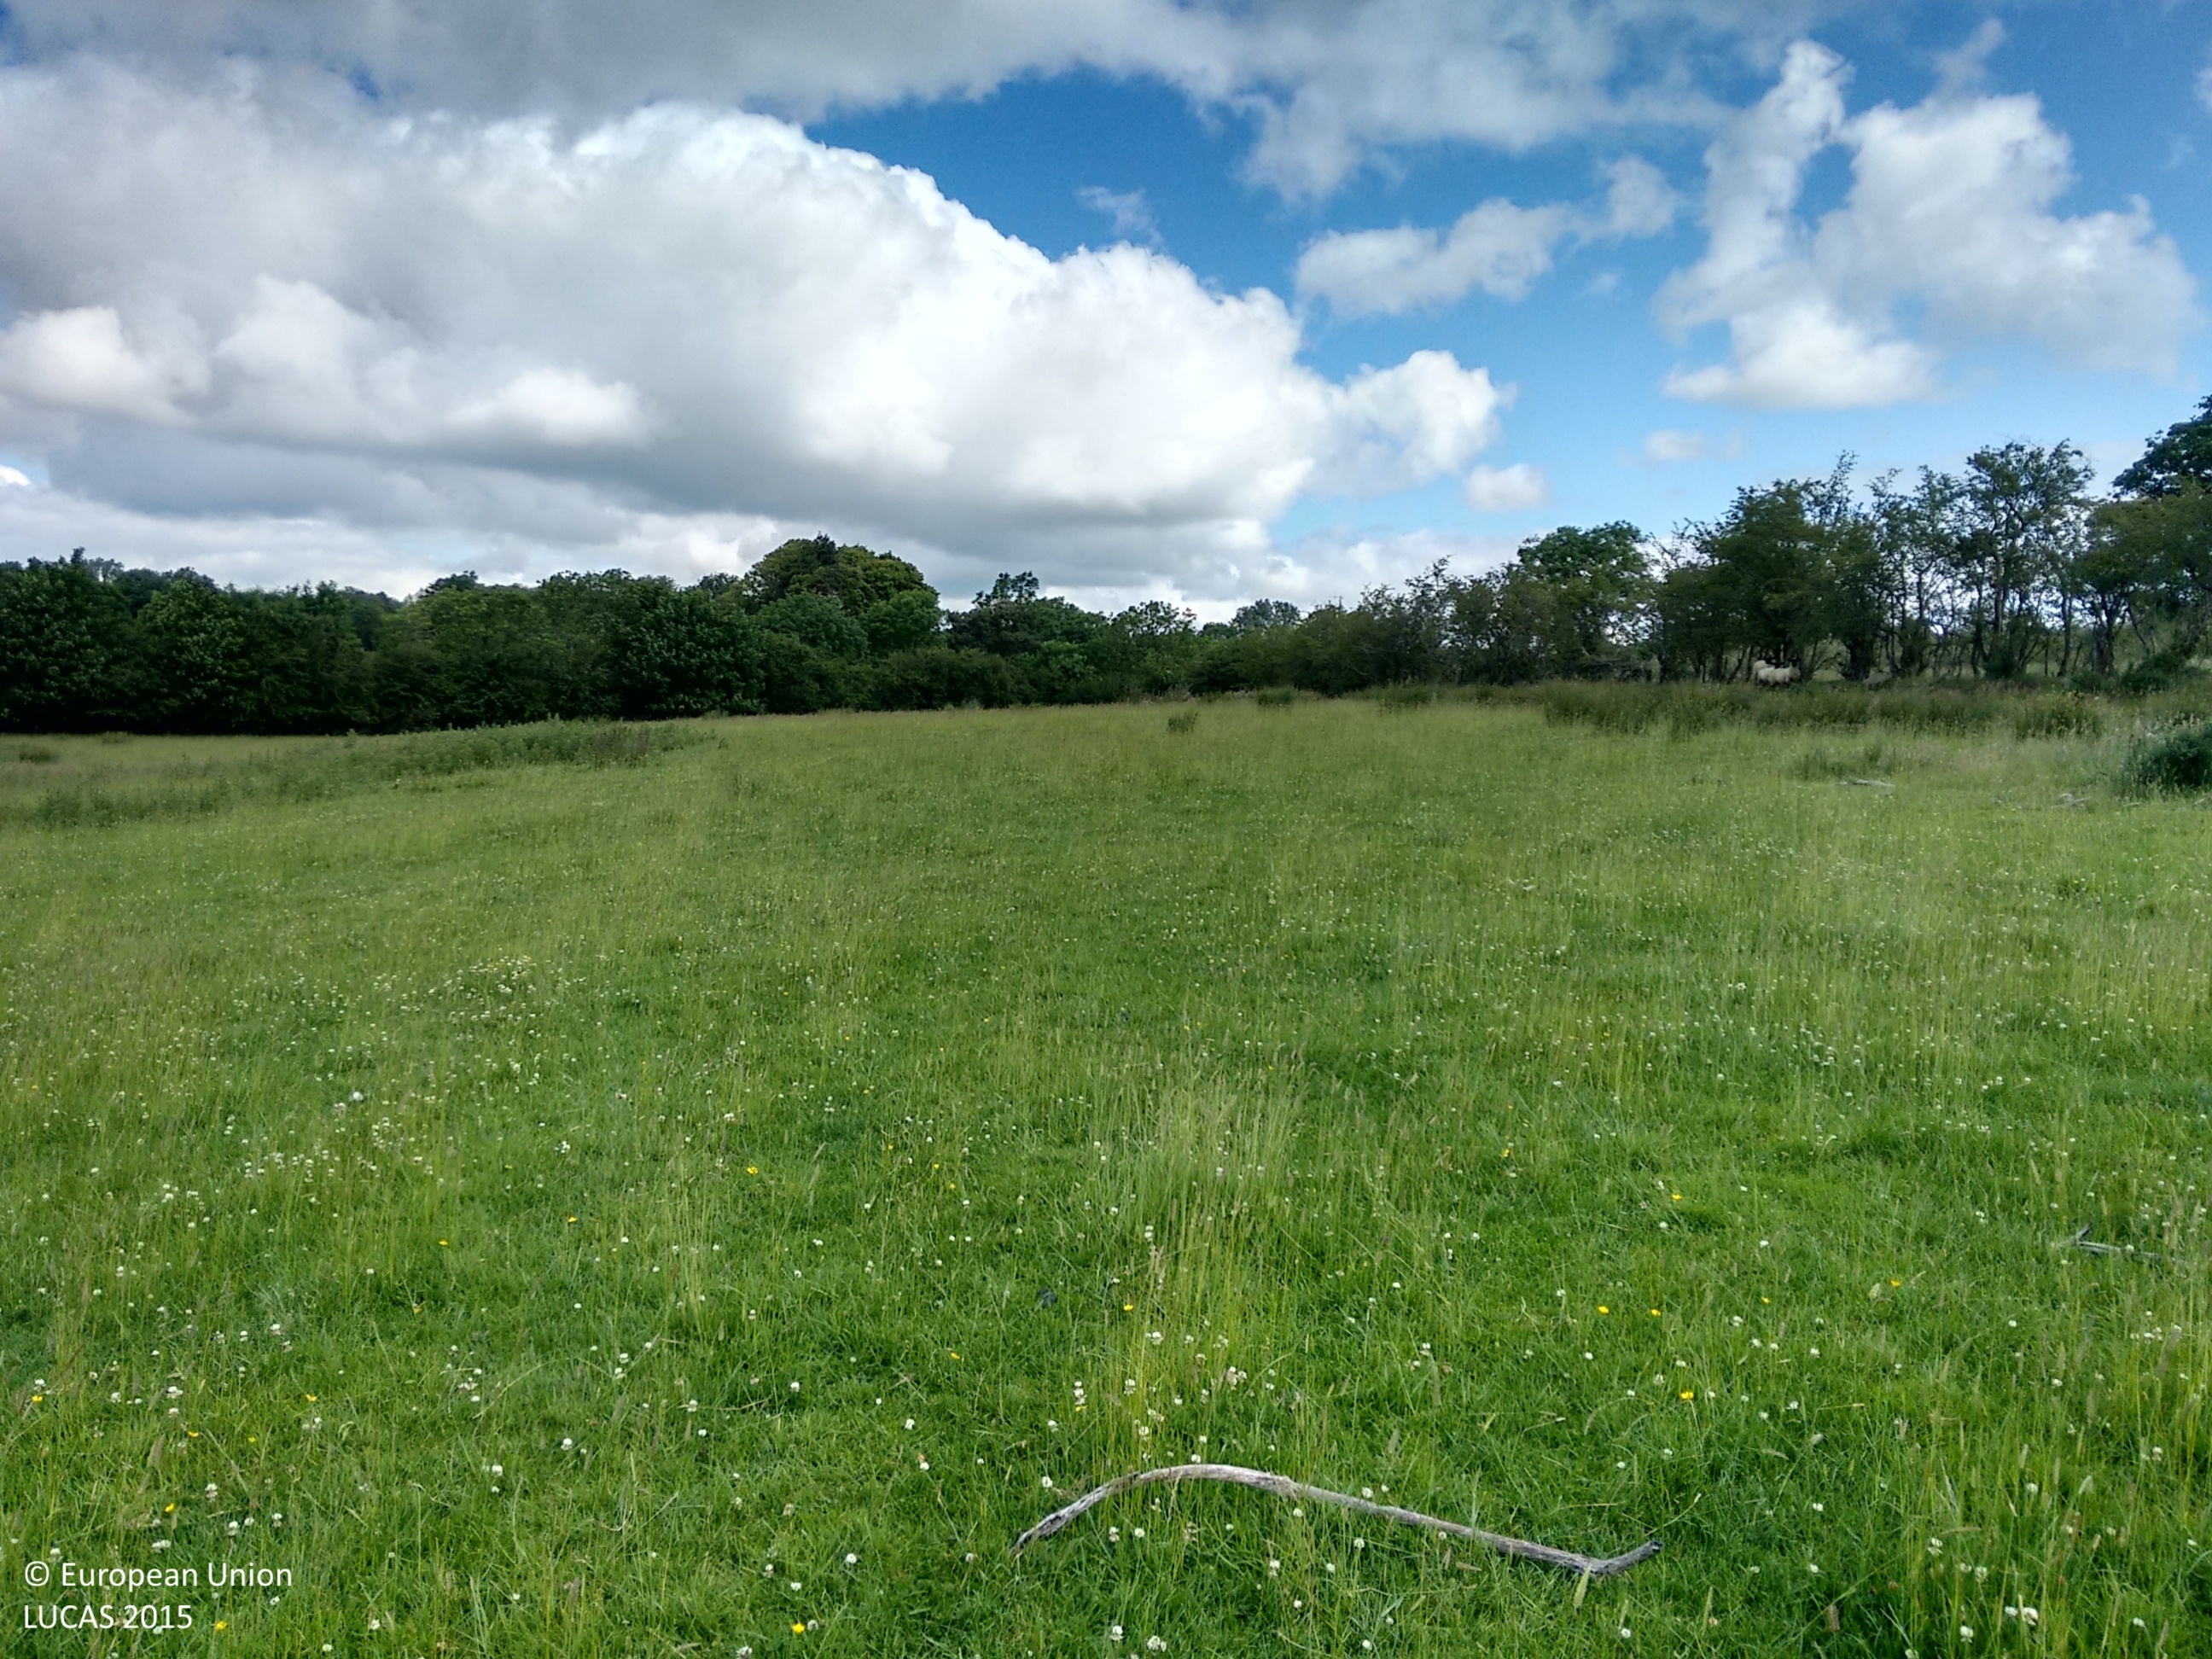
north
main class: Grassland
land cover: Grassland without tree/shrub cover
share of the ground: > 75 %
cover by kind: herbaceous plants 100 %
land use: Agriculture (excluding fallow land and kitchen gardens)
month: July
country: IE
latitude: 53.8463
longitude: -6.7153
